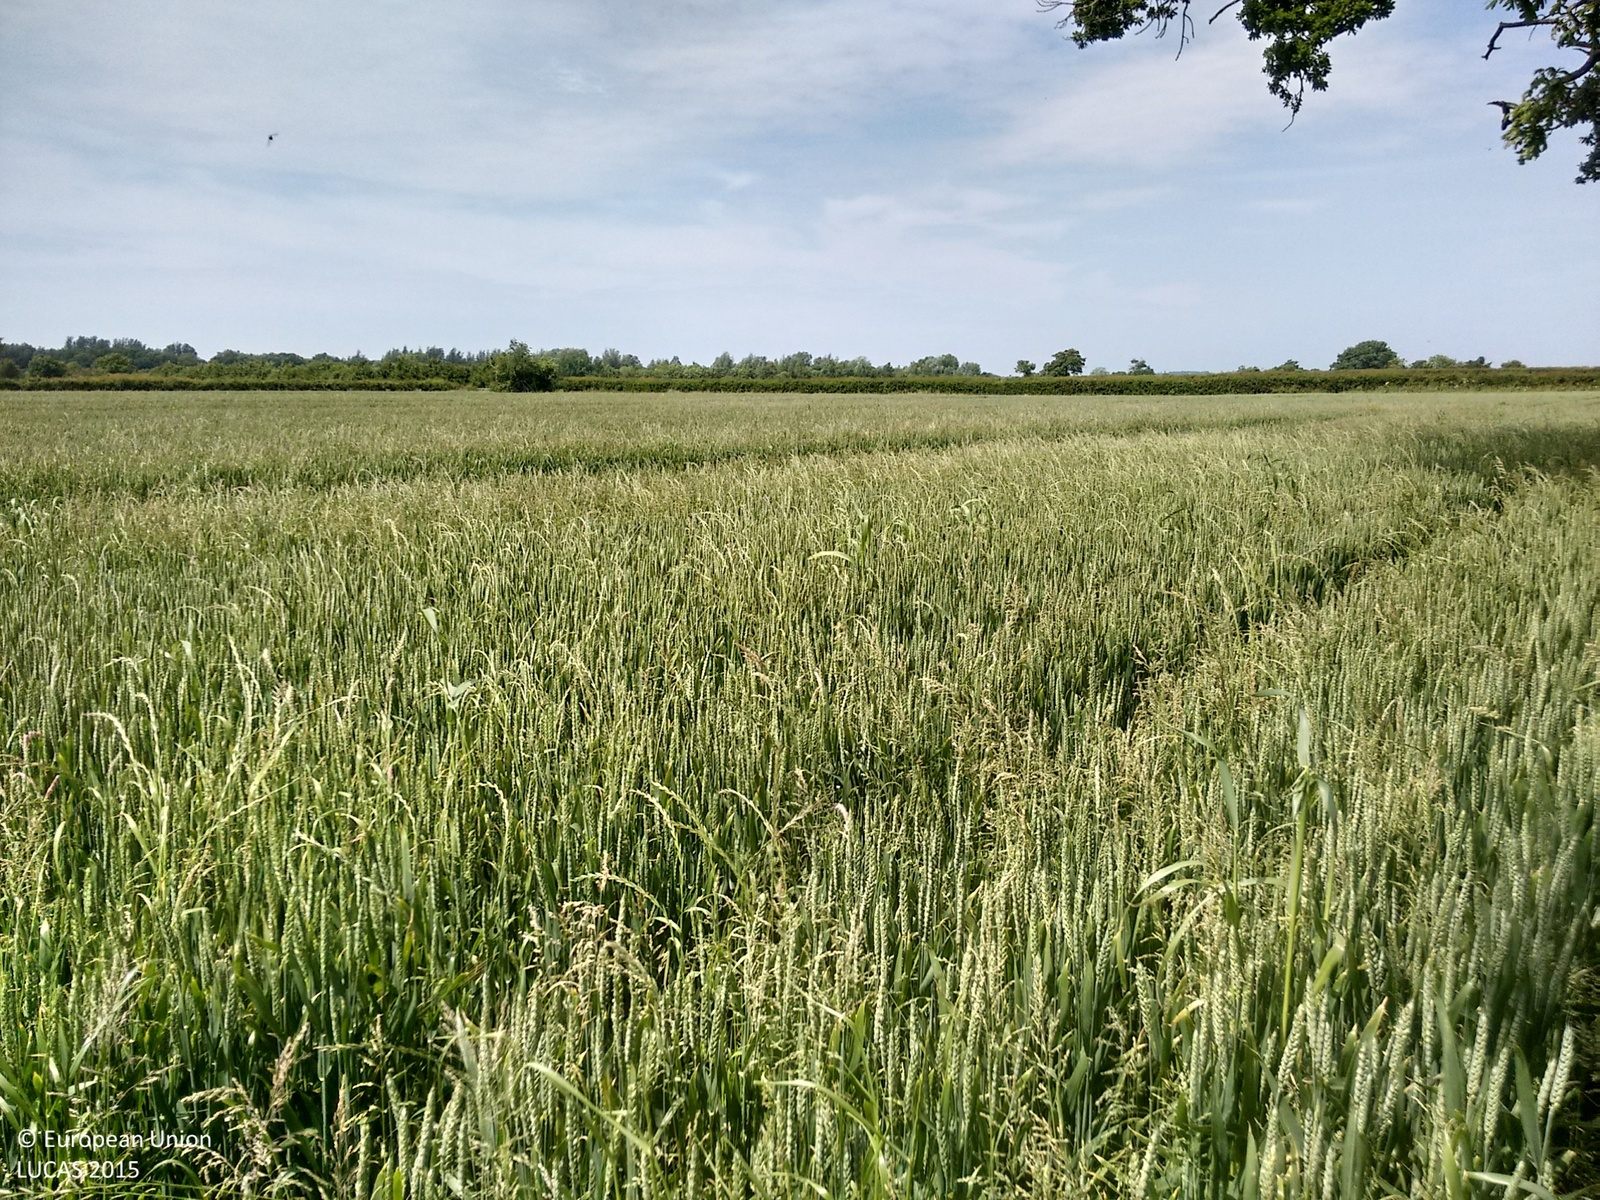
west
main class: Cropland
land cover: Common wheat
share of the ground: > 75 %
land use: Agriculture (excluding fallow land and kitchen gardens)
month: June
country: GB
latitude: 51.0072
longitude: -2.7983
